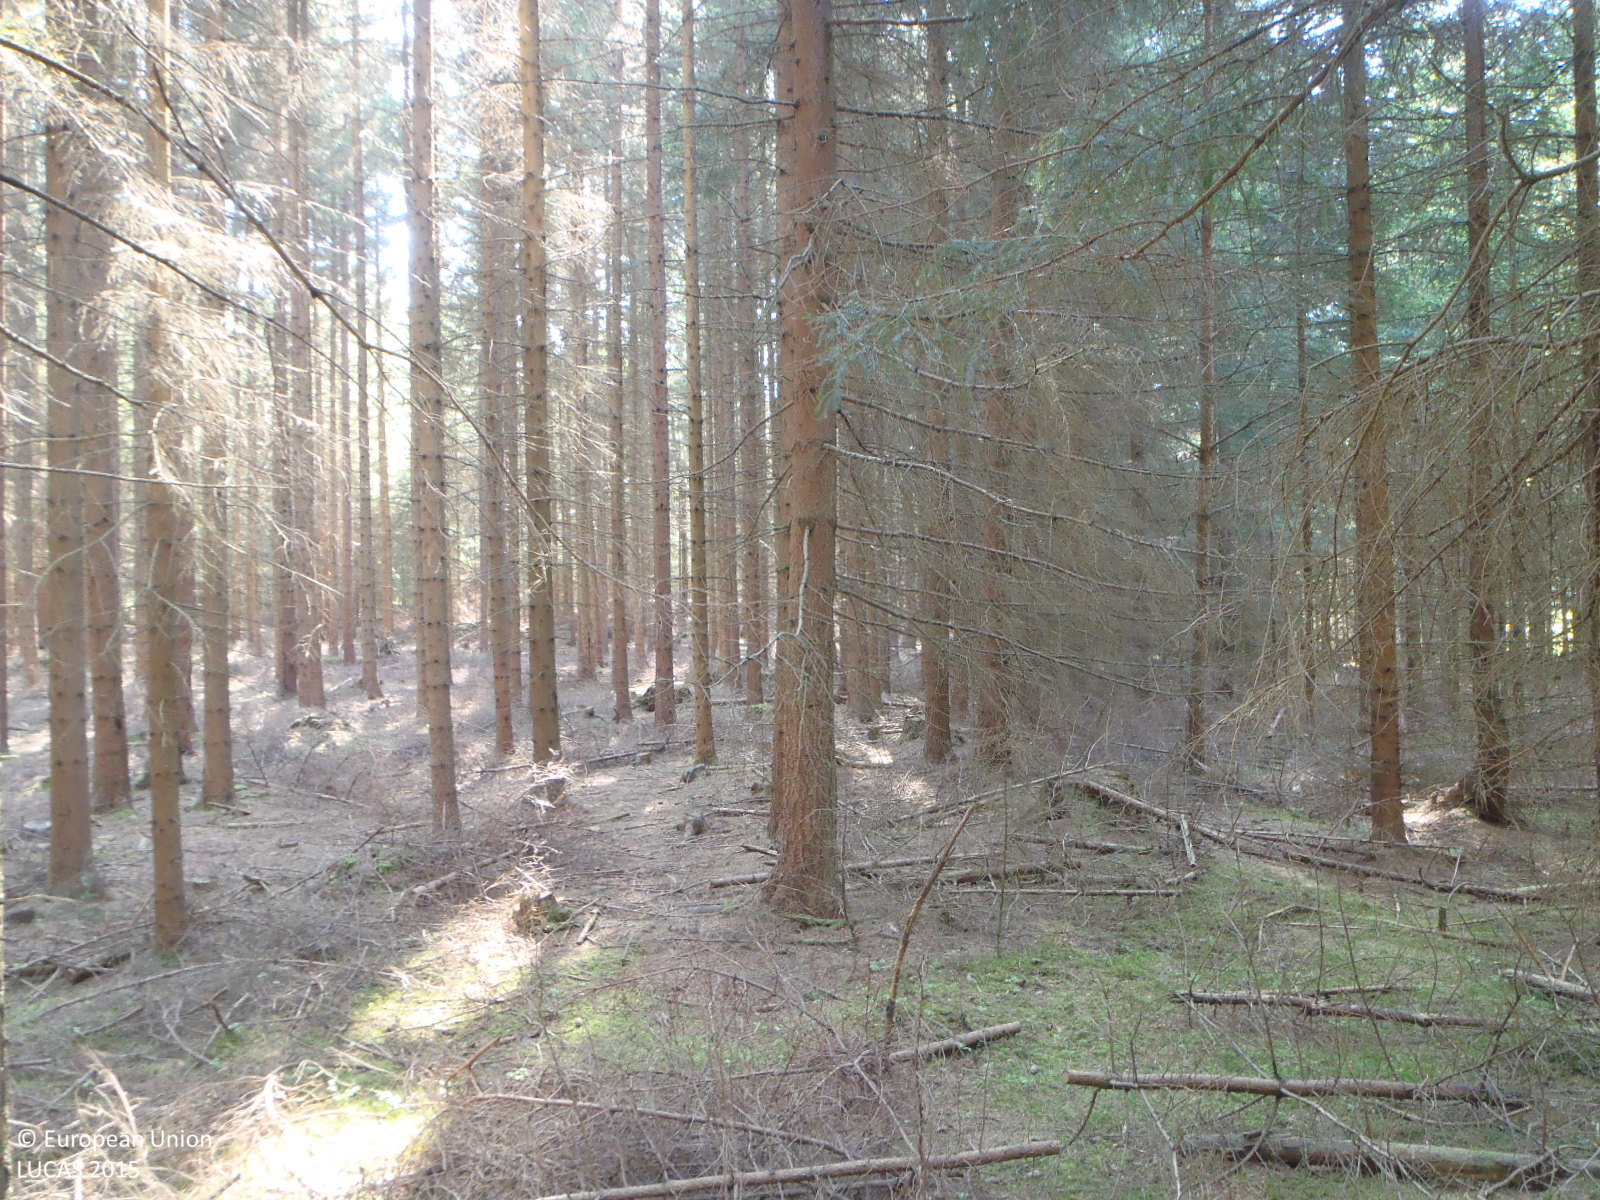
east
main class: Woodland
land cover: Spruce dominated coniferous woodland
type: hemiboreal forest and nemoral coniferous forest and mixed broadleaved-coniferous forest
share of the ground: > 75 %
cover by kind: coniferous forest trees 95 %, lichens and mosses 5 %
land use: Forestry
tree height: > 5 m
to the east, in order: Spruce dominated coniferous woodland; Other coniferous woodland; Tracks; Other coniferous woodland; Other mixed woodland; Other coniferous woodland
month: May
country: CZ
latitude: 49.0081
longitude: 15.0742
